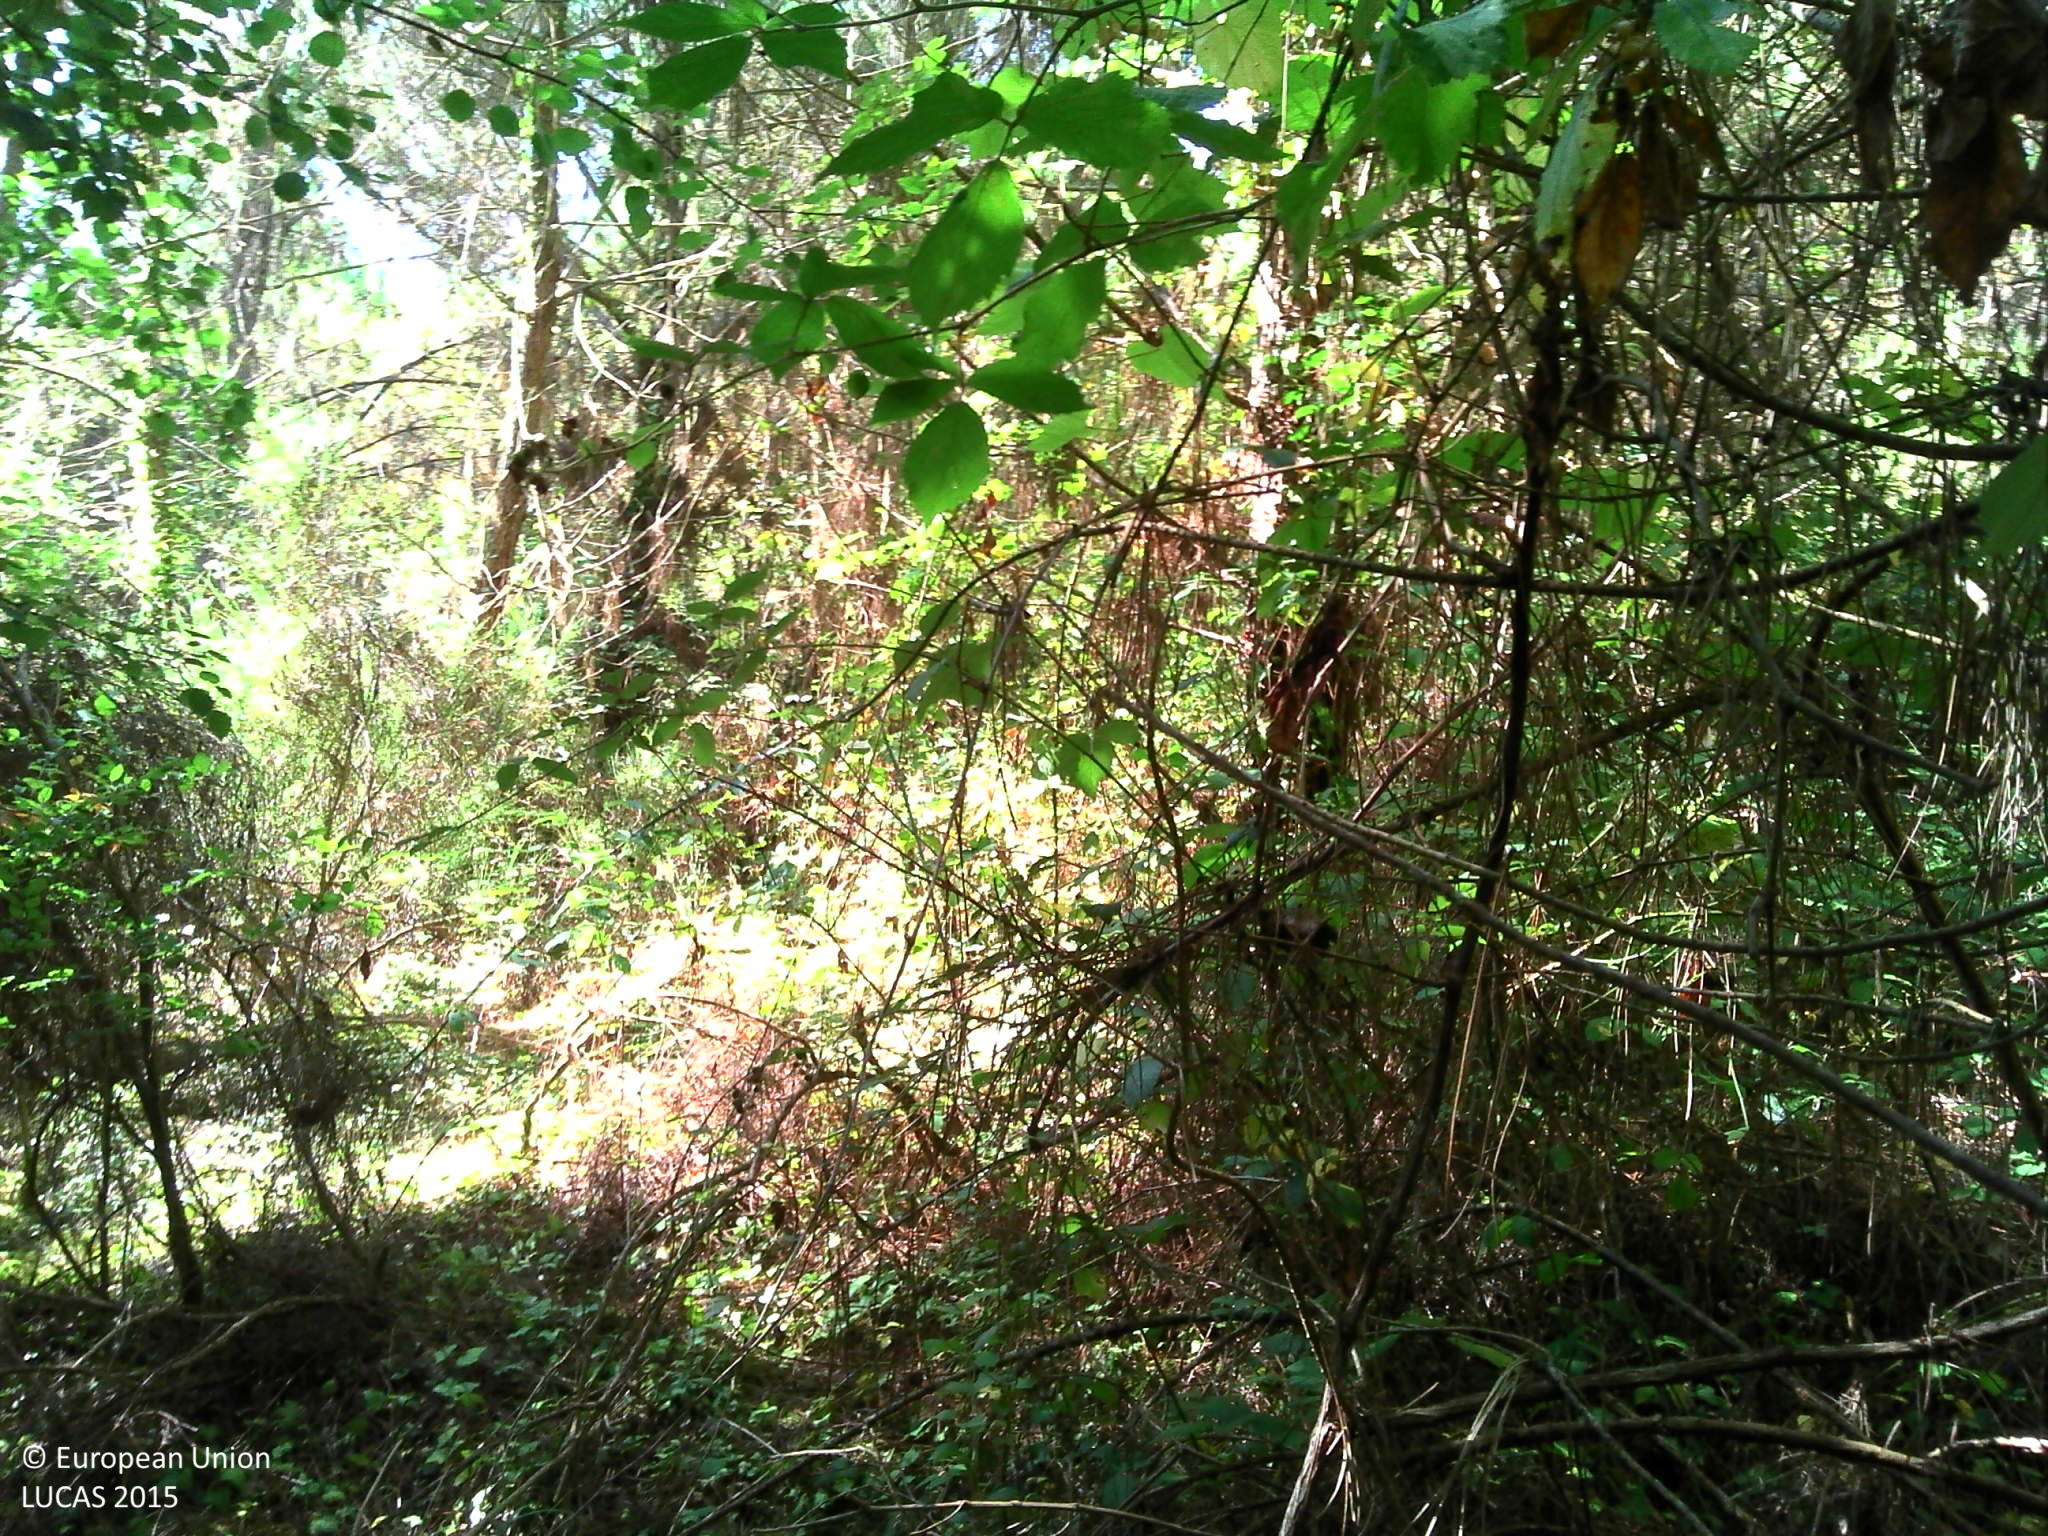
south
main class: Woodland
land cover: Pine dominated mixed woodland
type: thermophilous deciduous forest
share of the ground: > 75 %
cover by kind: coniferous forest trees 50 %, broadleaved forest trees 20 %, shrubs 20 %, herbaceous plants 5 %, lichens and mosses 5 %
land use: Forestry
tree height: > 5 m
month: July
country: FR
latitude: 45.0527
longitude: 0.4531
